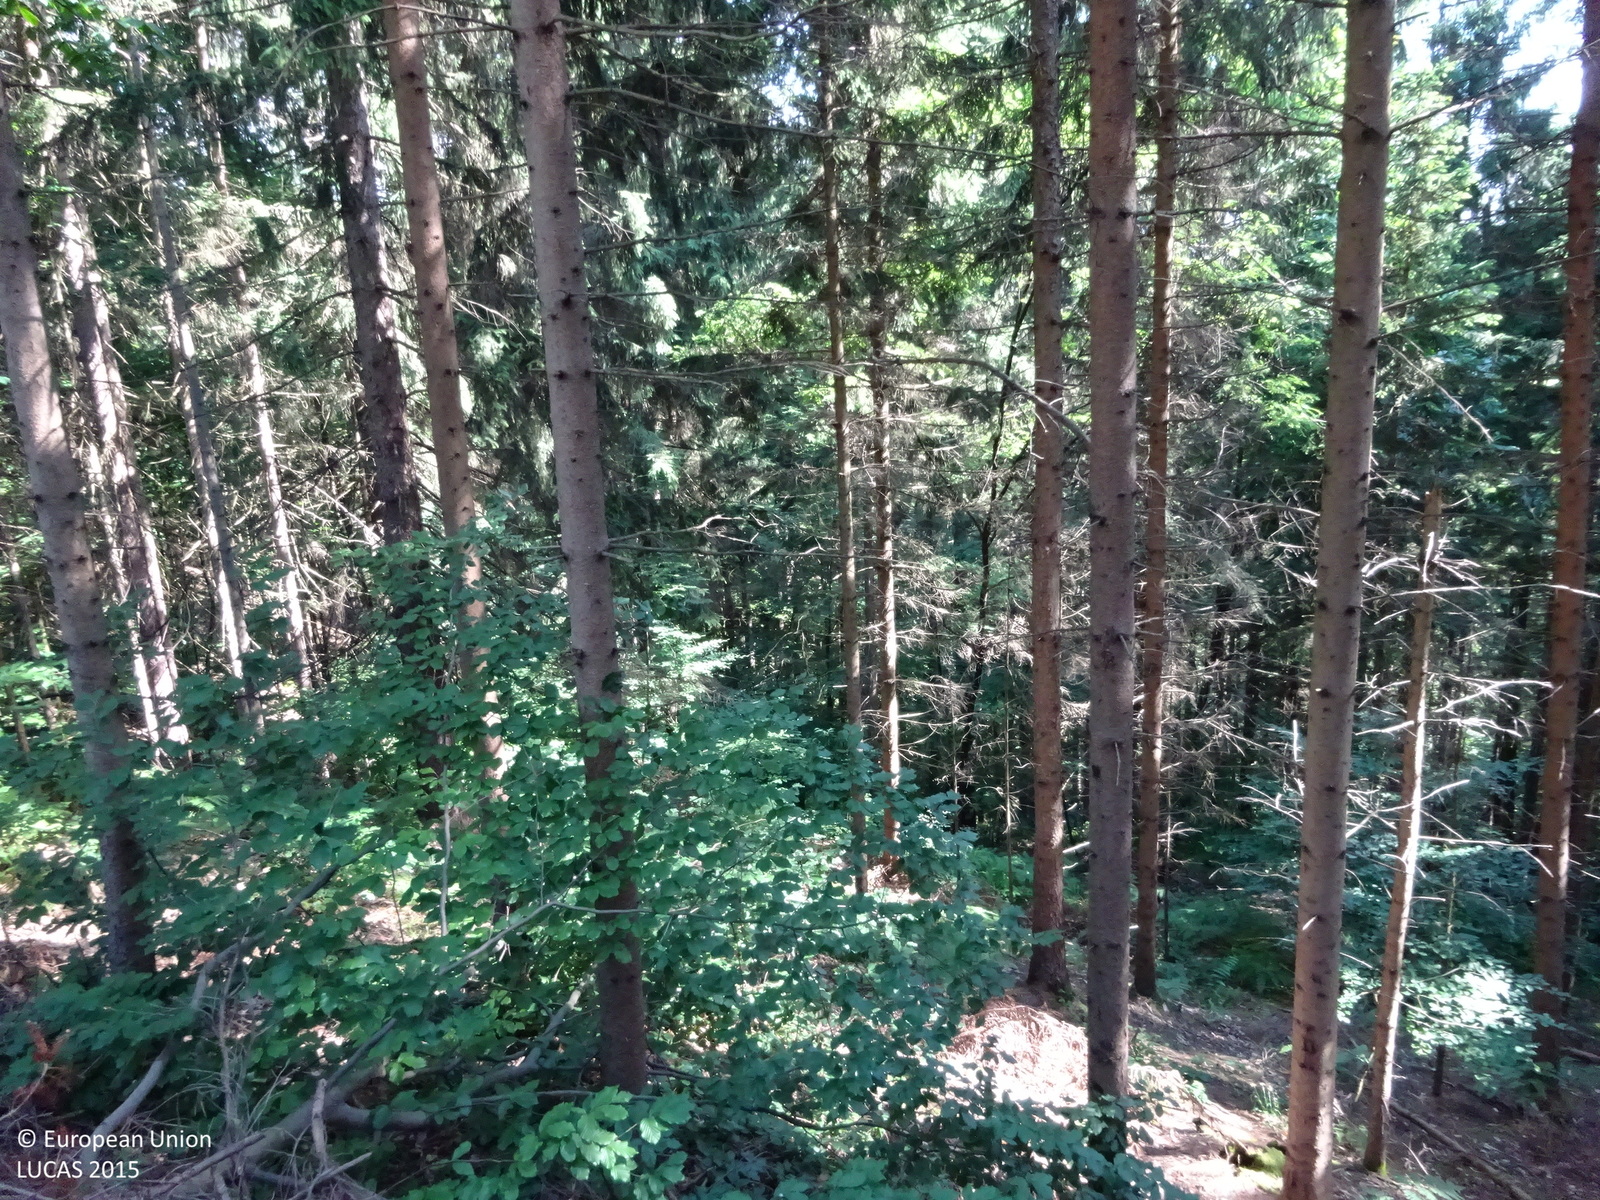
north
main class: Woodland
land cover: Spruce dominated coniferous woodland
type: alpine coniferous forest
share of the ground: > 75 %
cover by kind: coniferous forest trees 95 %, broadleaved forest trees 5 %
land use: Forestry
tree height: > 5 m
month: June
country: AT
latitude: 46.6727
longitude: 15.2665
